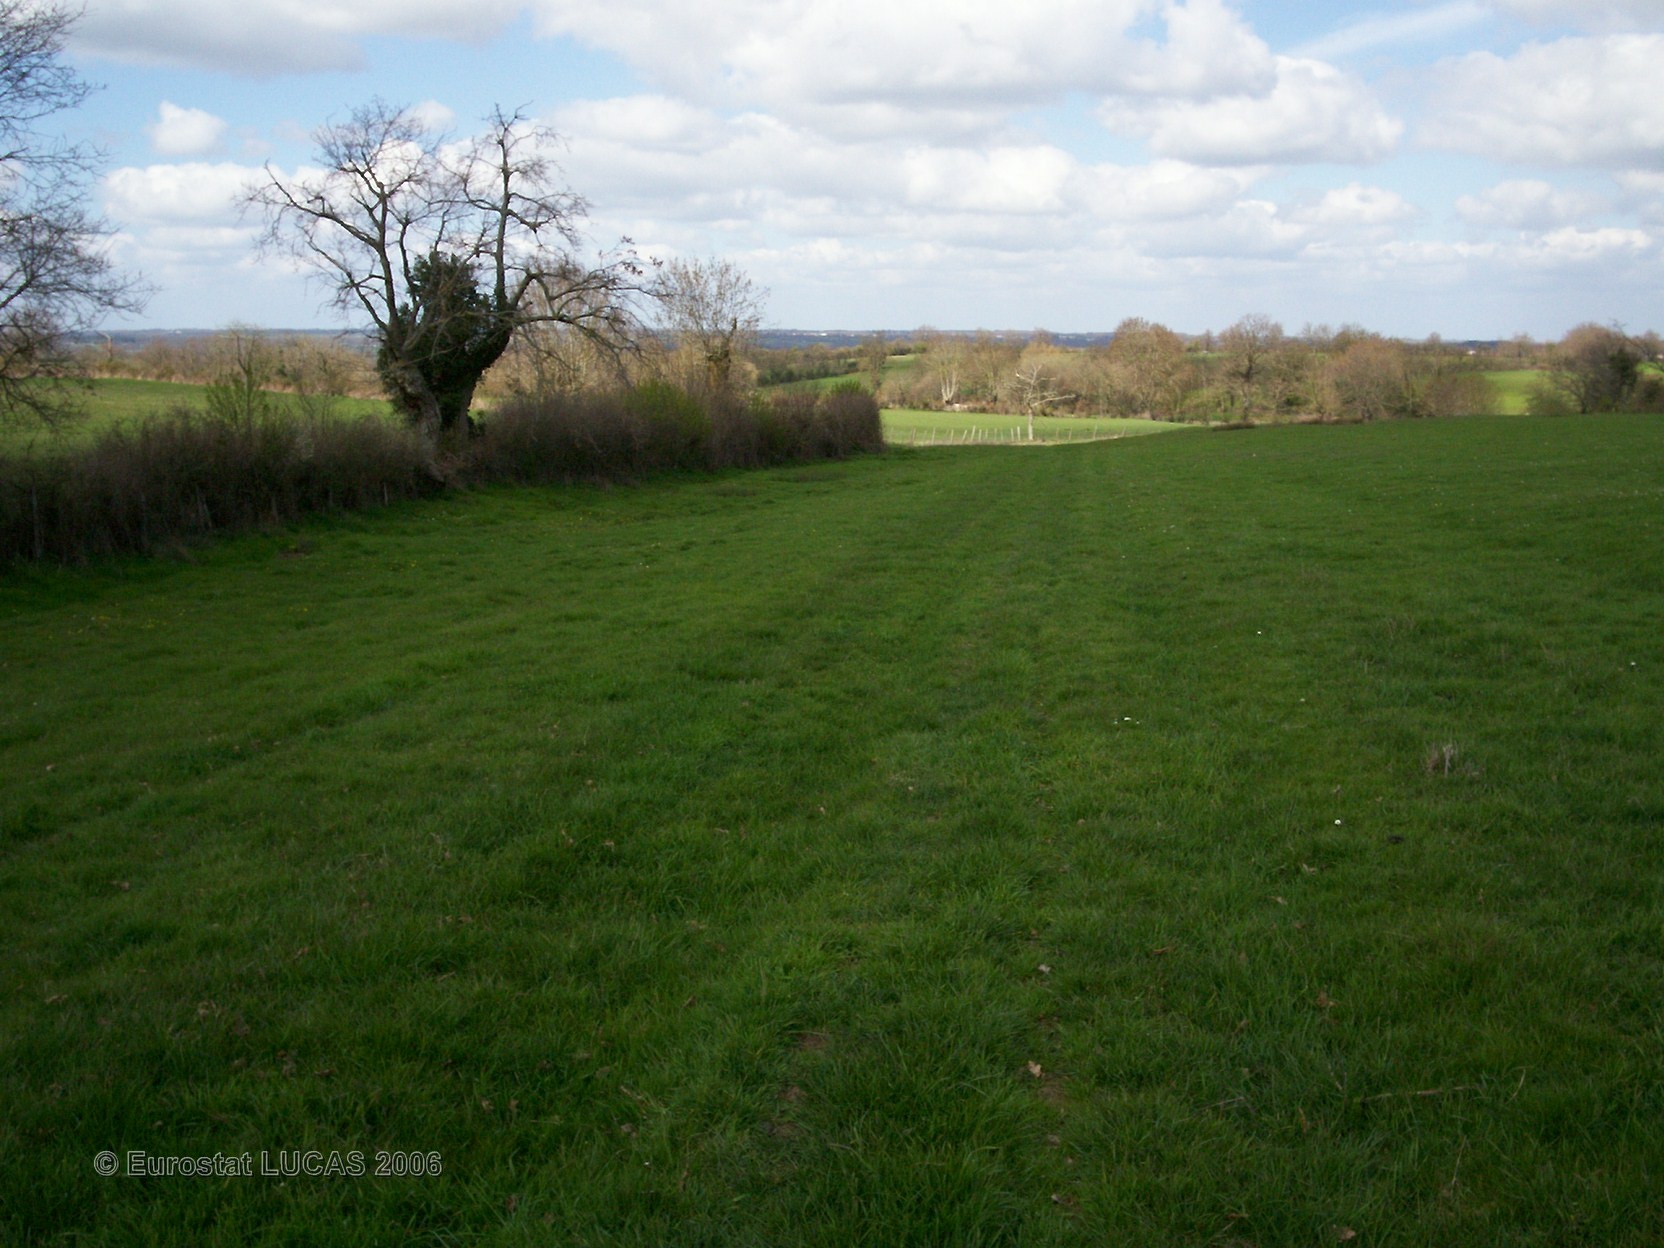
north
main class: Grassland
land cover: Grassland without tree/shrub cover
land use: Agriculture (excluding fallow land and kitchen gardens)
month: April
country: FR
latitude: 46.7726
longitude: -0.3589
